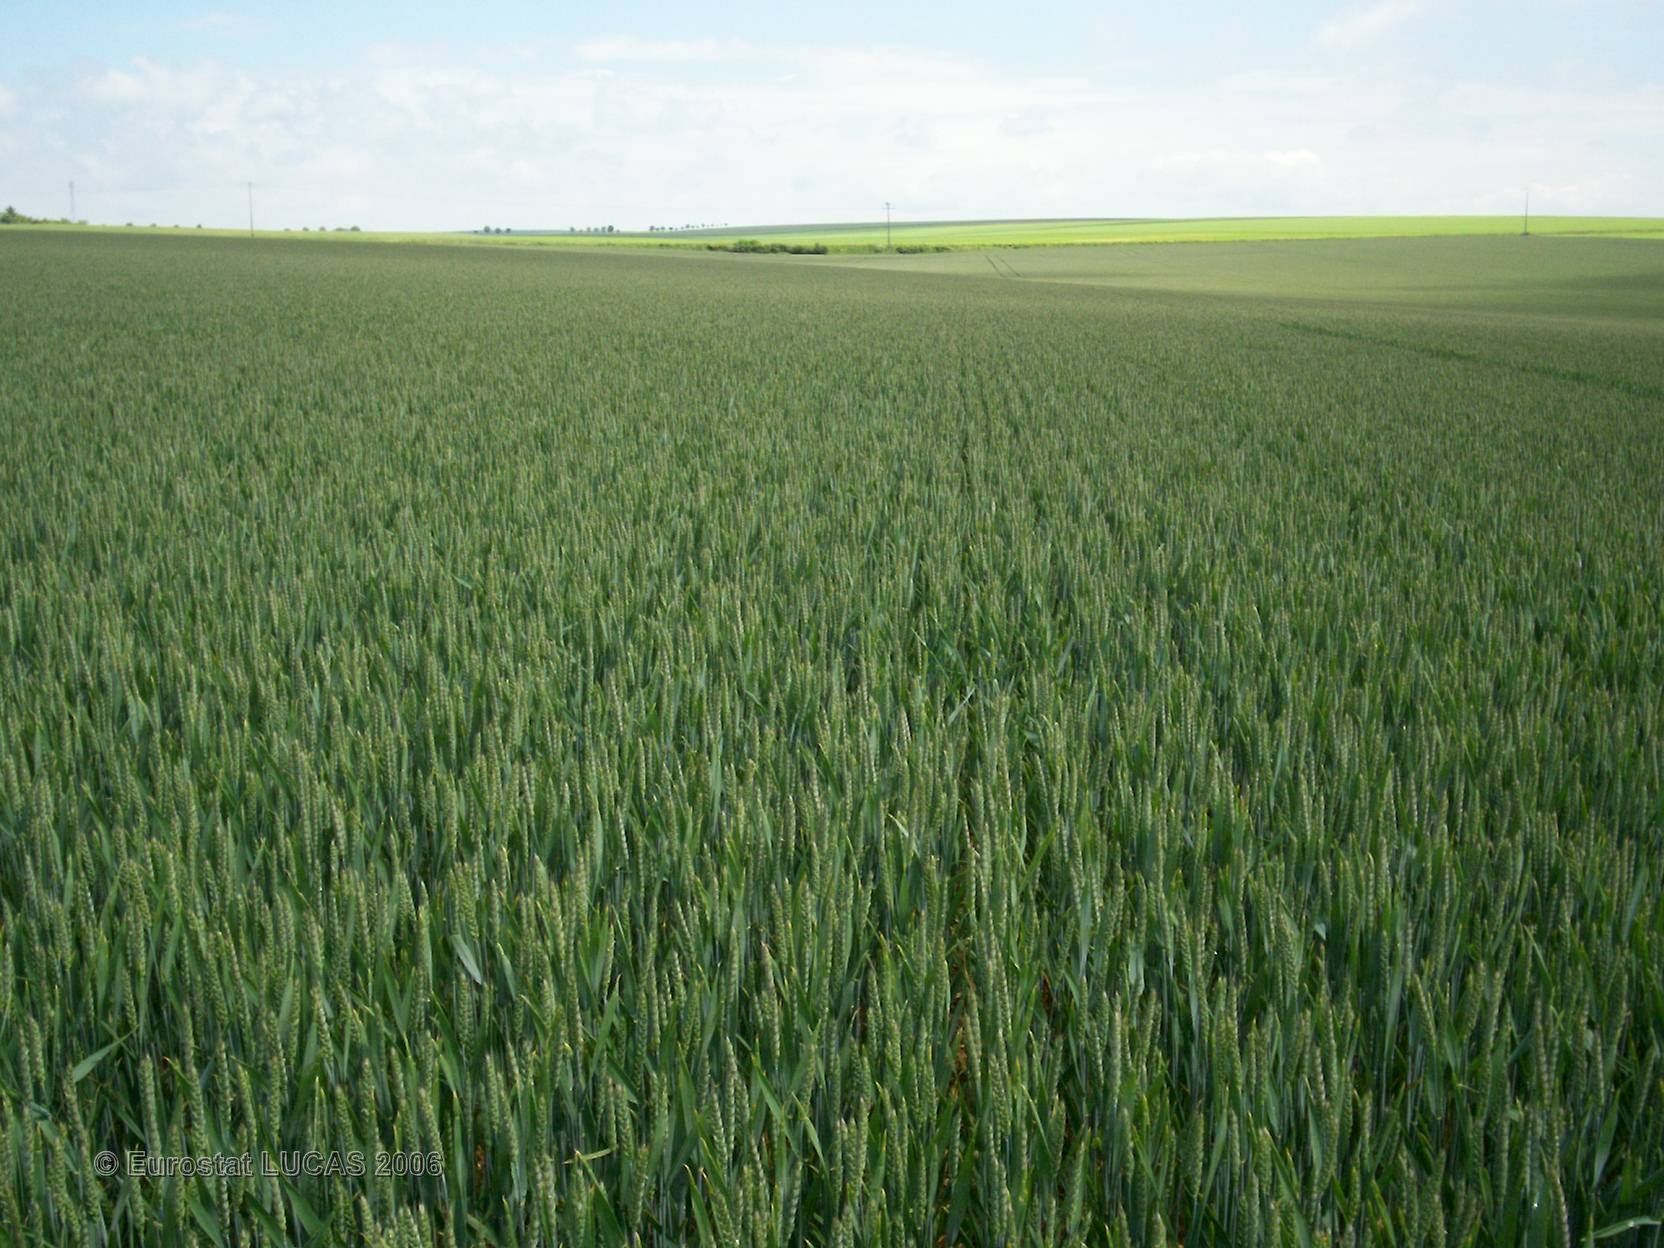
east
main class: Cropland
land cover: Common wheat
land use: Agriculture (excluding fallow land and kitchen gardens)
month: June
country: FR
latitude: 48.6054
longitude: 4.4230
